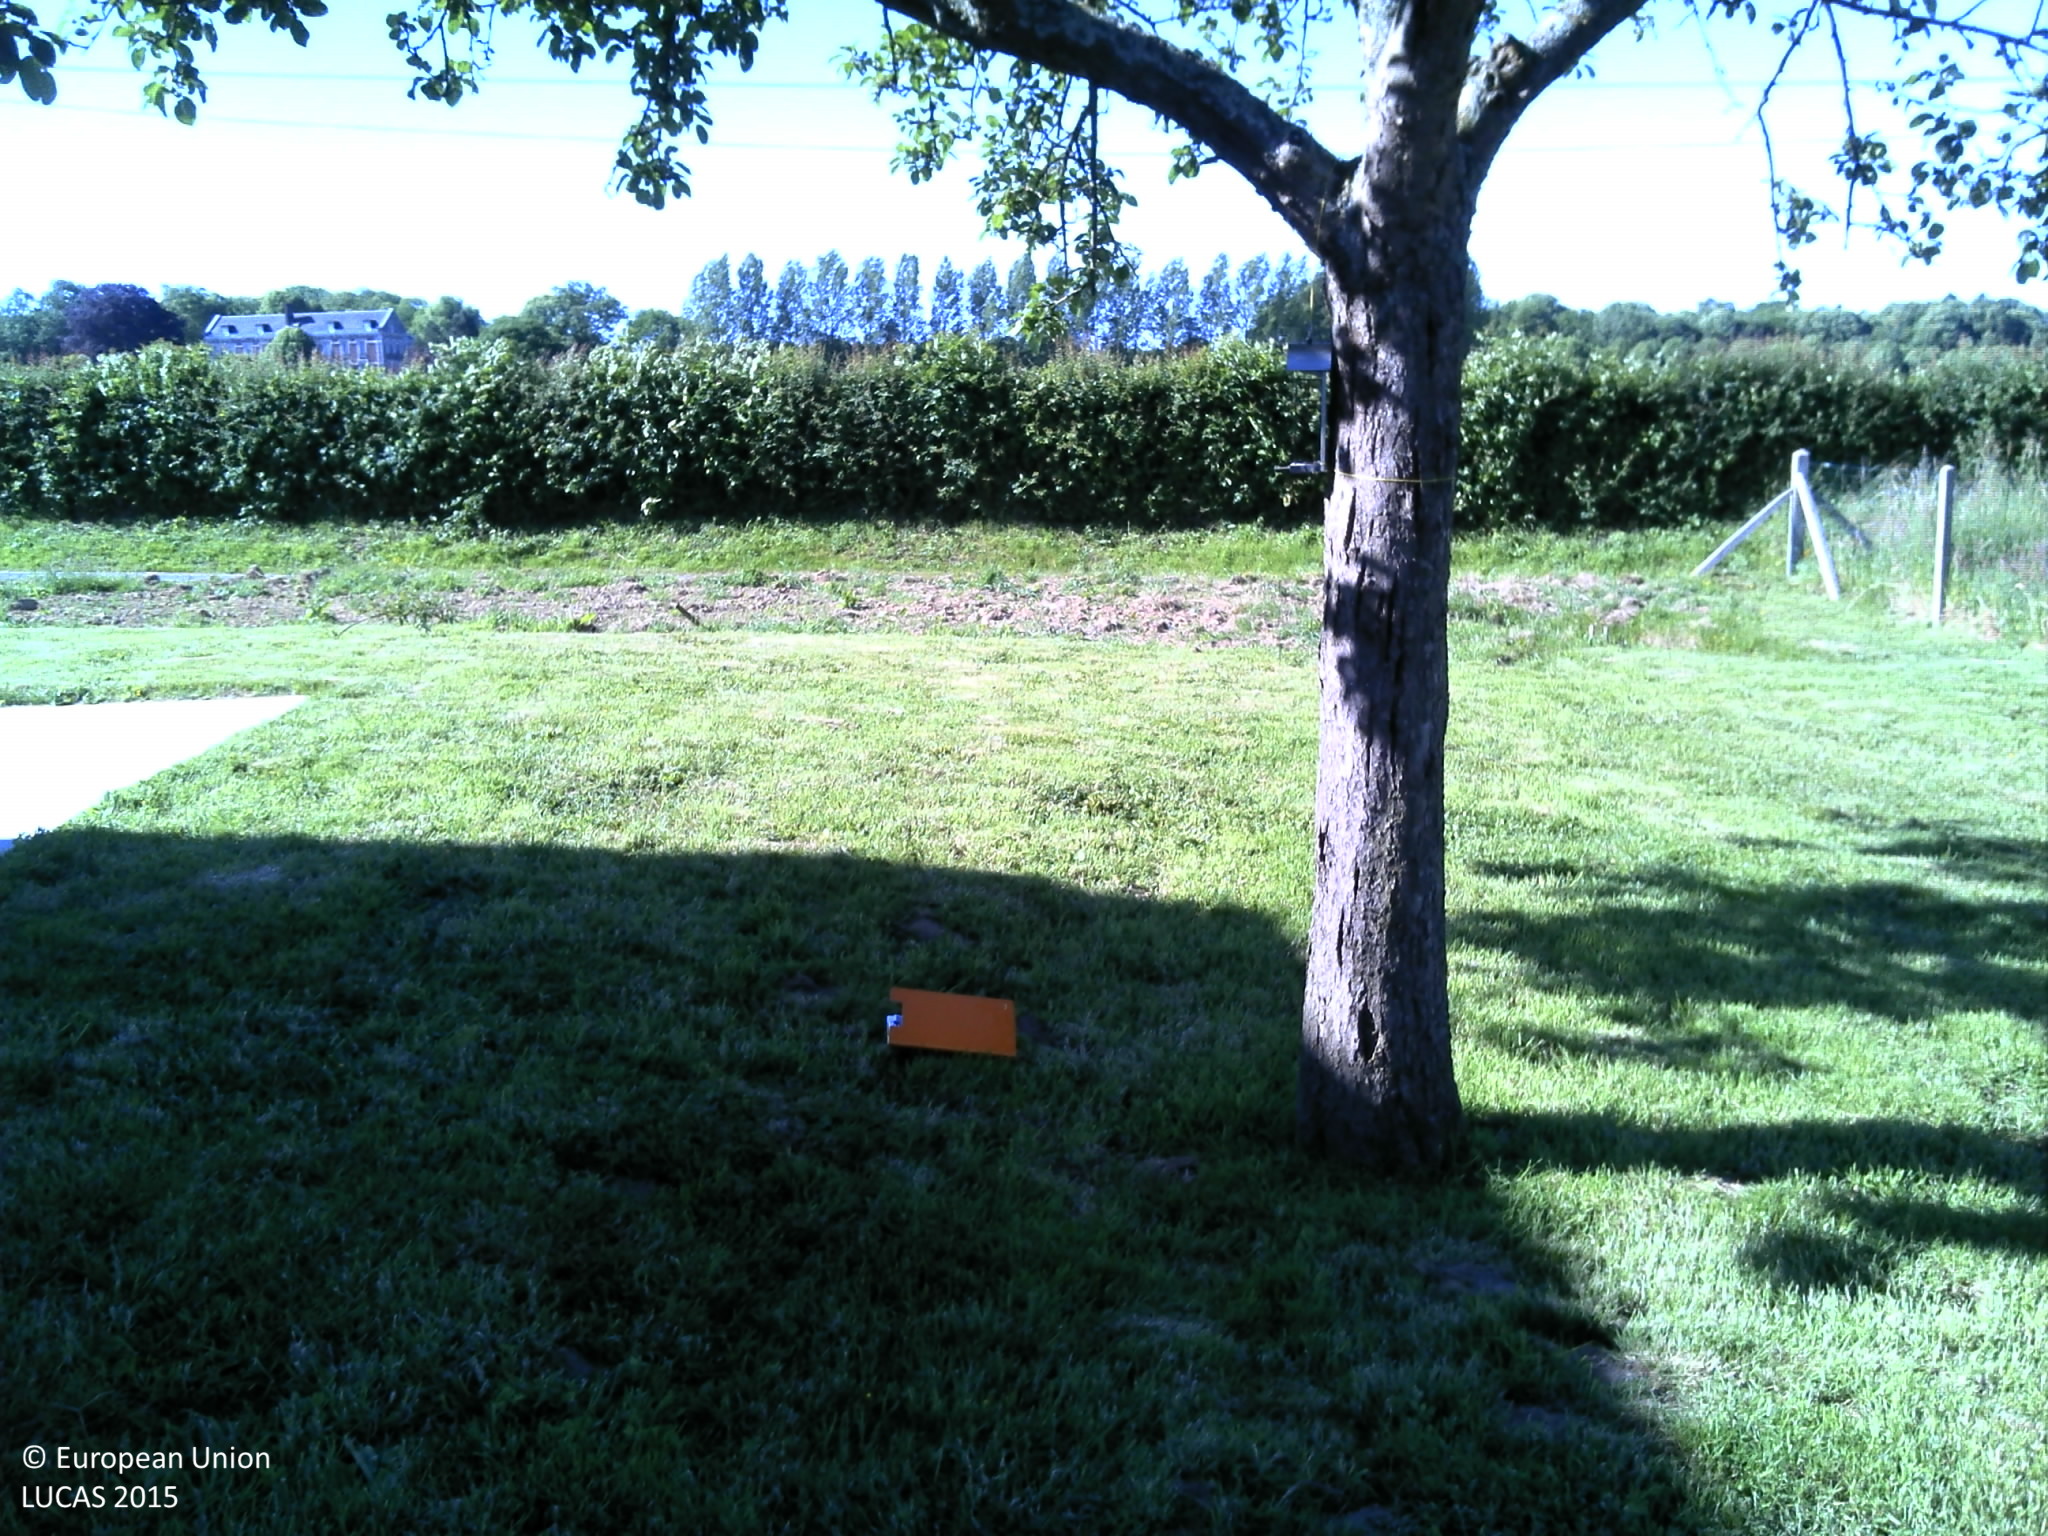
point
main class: Grassland
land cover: Grassland with sparse tree/shrub cover
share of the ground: > 75 %
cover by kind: herbaceous plants 95 %, broadleaved forest trees 5 %
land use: Residential
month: June
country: FR
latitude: 49.5833
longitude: 1.1125
